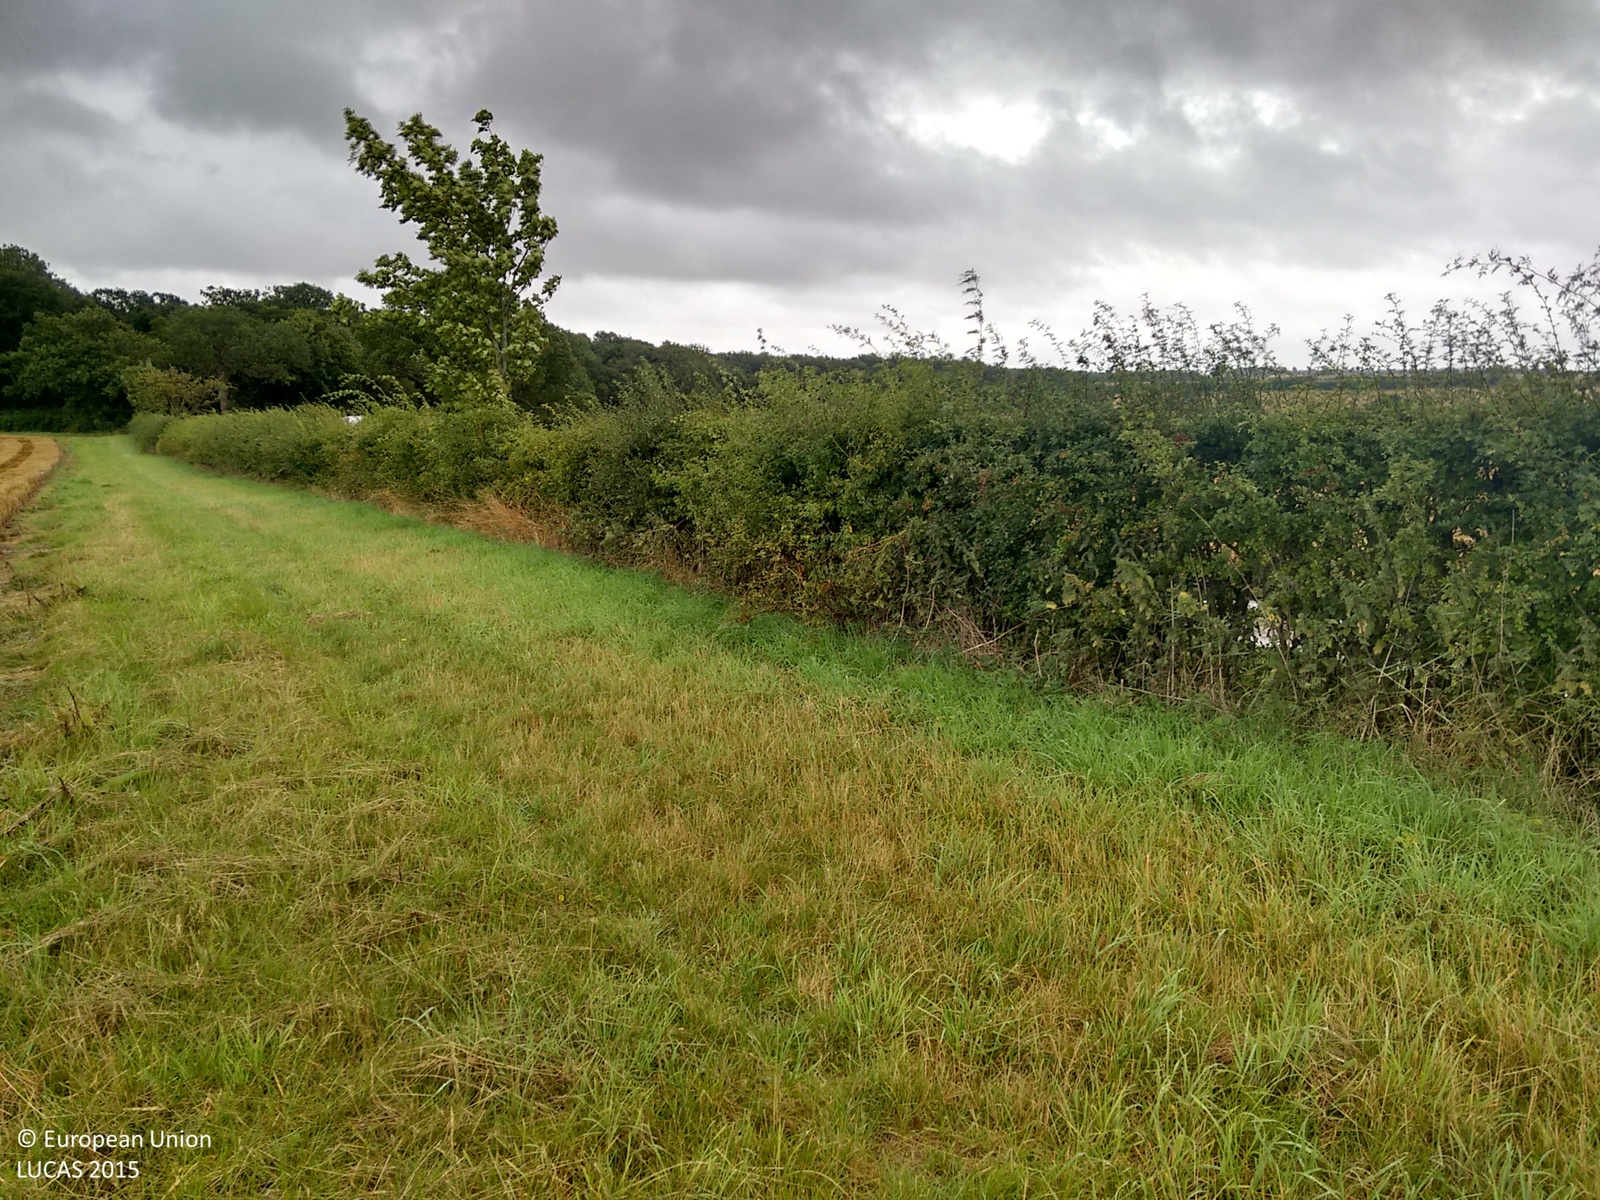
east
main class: Cropland
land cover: Common wheat
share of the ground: > 75 %
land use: Agriculture (excluding fallow land and kitchen gardens)
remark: Harvested field
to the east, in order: Grass margins; Managed hedges; Ditches and canals; Grass margins; Tracks; Common wheat; Tracks; Grass margins; Ditches and canals; Managed hedges; Grassland without tree/shrub cover; Common wheat; Grass margins; Tracks; Grass margins; Ditches and canals; Broadleaved woodland
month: August
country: GB
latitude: 52.1196
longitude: 0.4642
